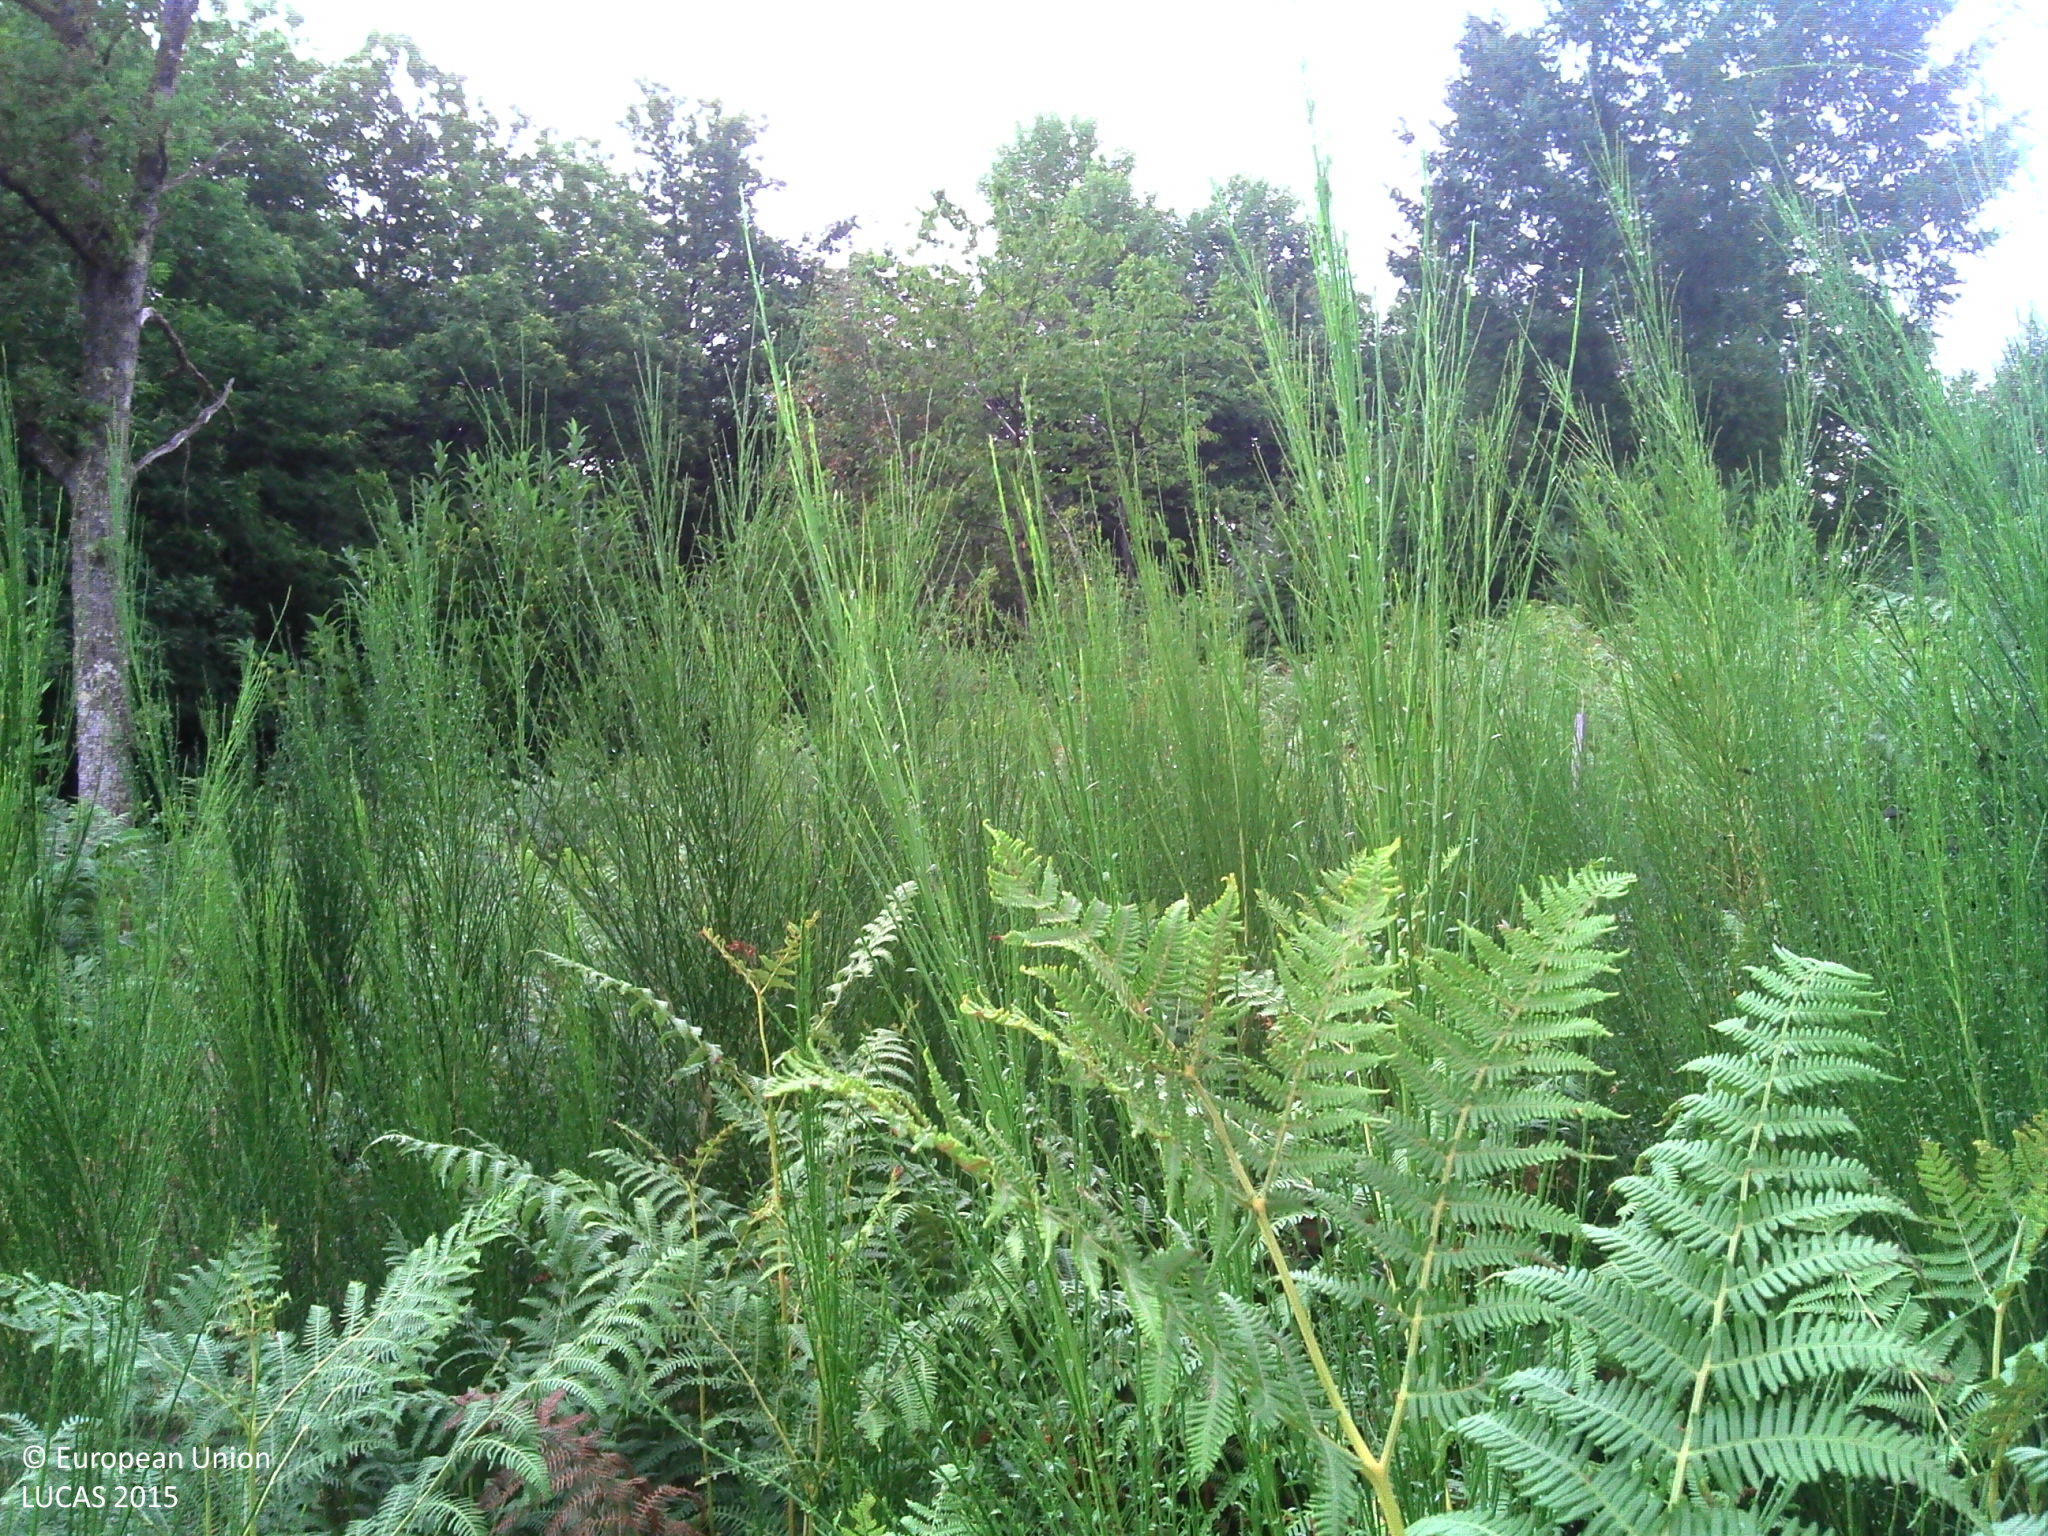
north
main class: Woodland
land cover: Spruce dominated coniferous woodland
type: exotic forest
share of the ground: 25 - 50 %
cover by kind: herbaceous plants 40 %, coniferous forest trees 30 %, shrubs 15 %, lichens and mosses 10 %, broadleaved forest trees 5 %
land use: Forestry
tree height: > 5 m
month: August
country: FR
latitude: 45.5396
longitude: 1.0388
